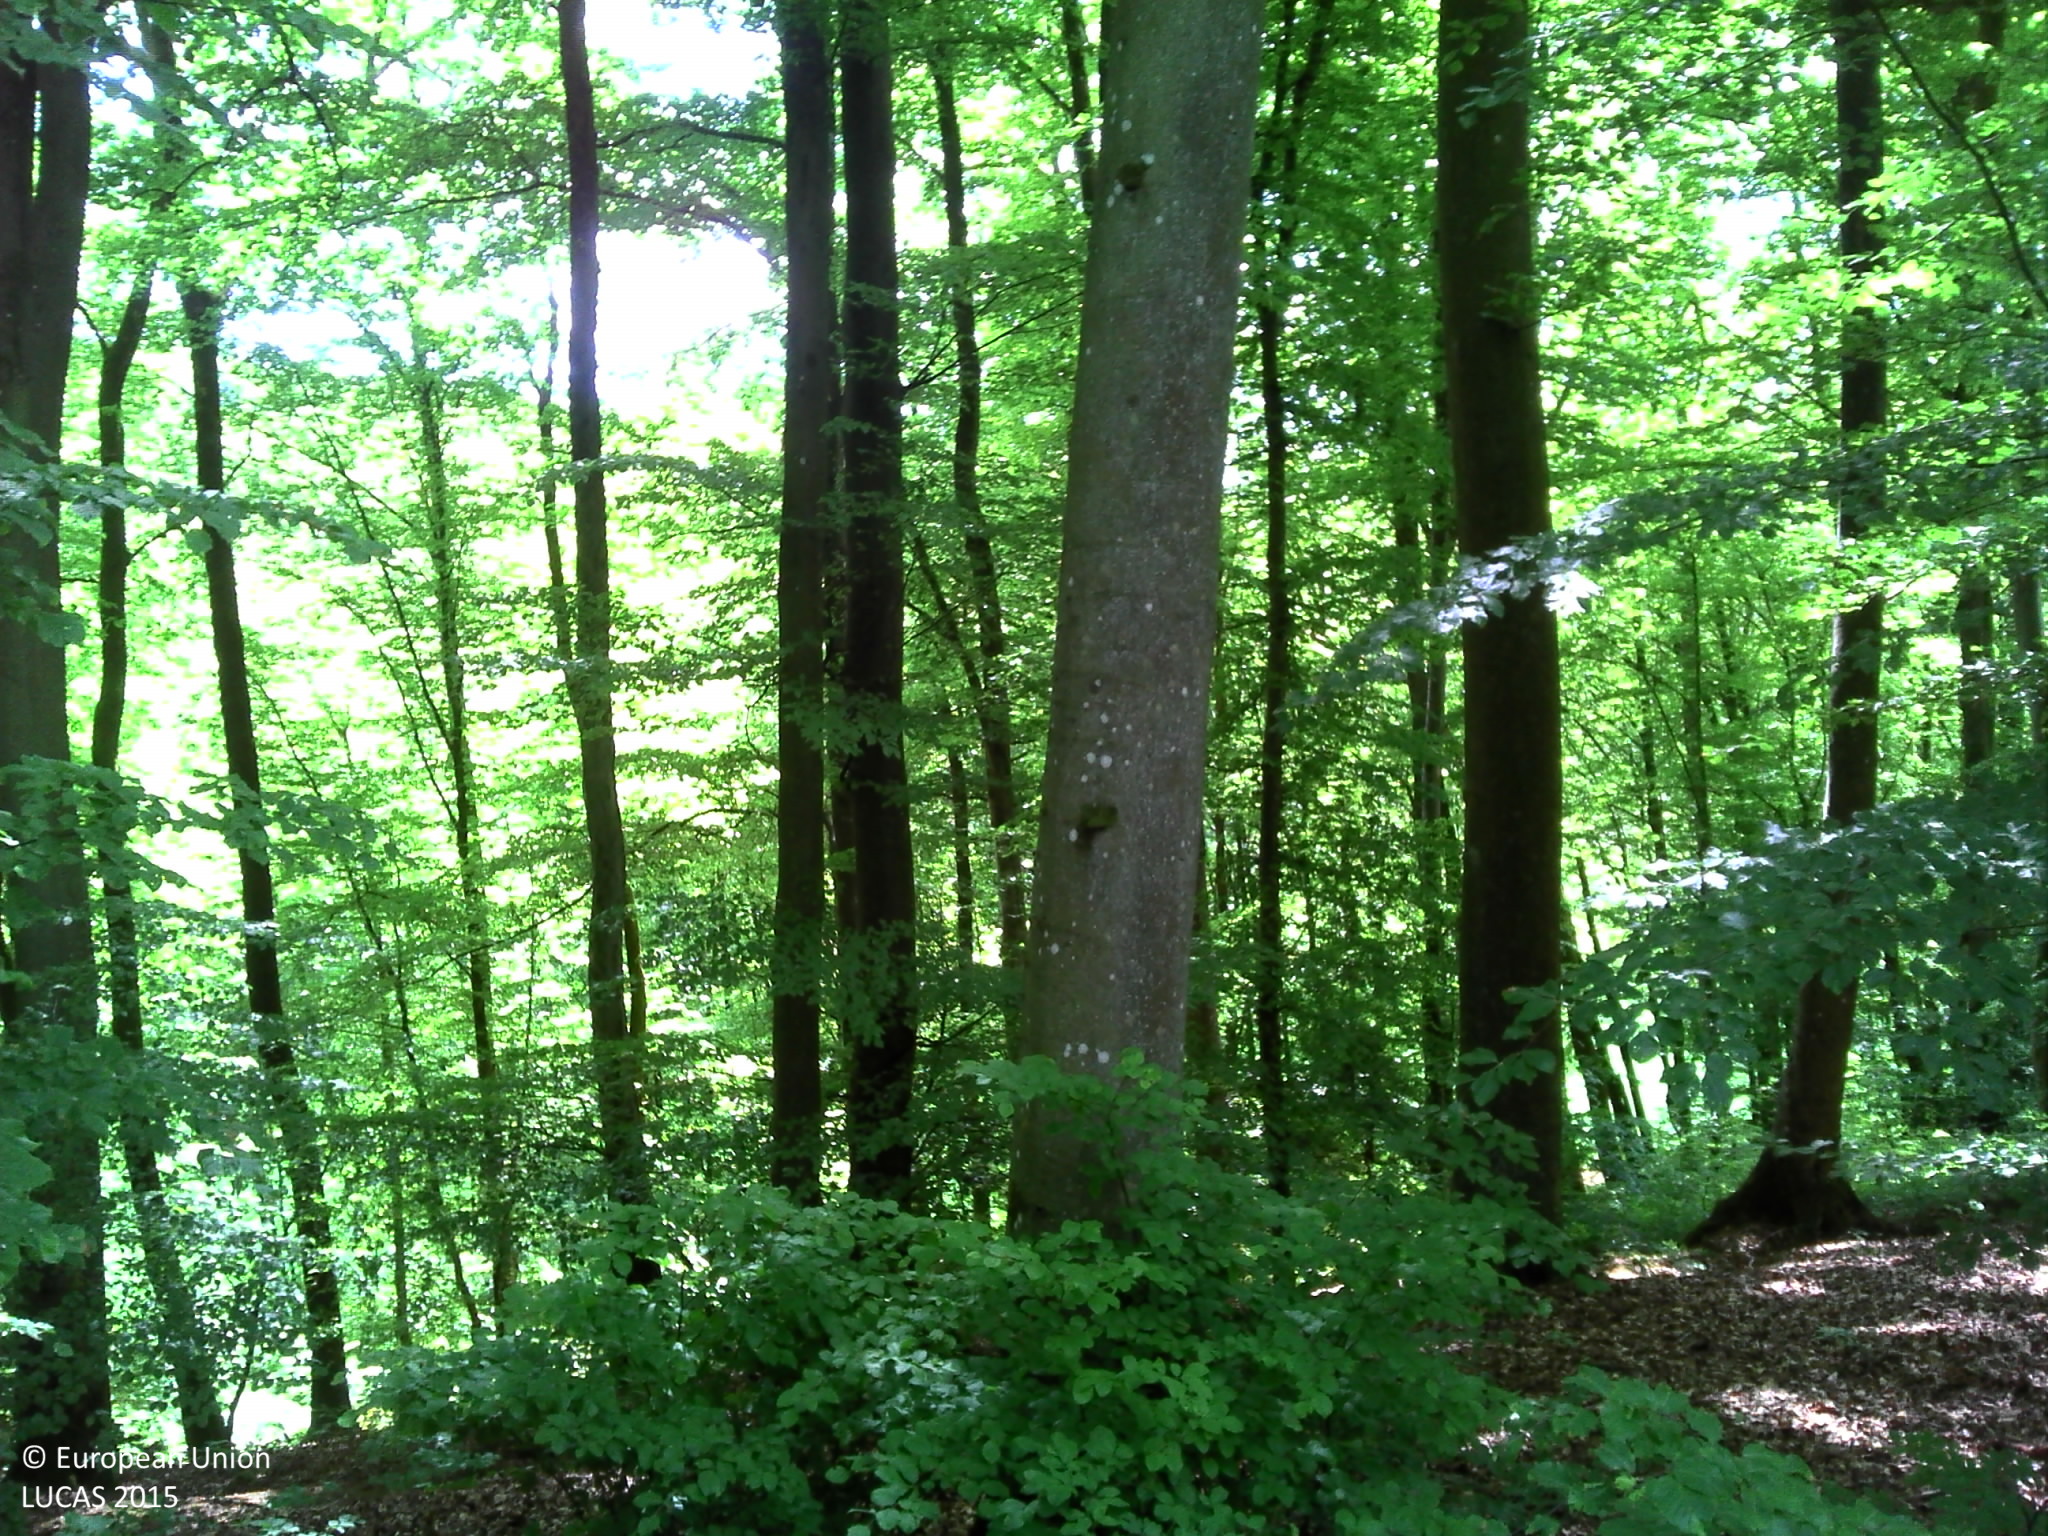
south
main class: Woodland
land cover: Broadleaved woodland
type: acidophilous oak and oak-birch forest
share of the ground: > 75 %
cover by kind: broadleaved forest trees 95 %, coniferous forest trees 5 %
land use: Forestry
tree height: > 5 m
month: May
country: LU
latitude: 49.6967
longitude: 5.9093
